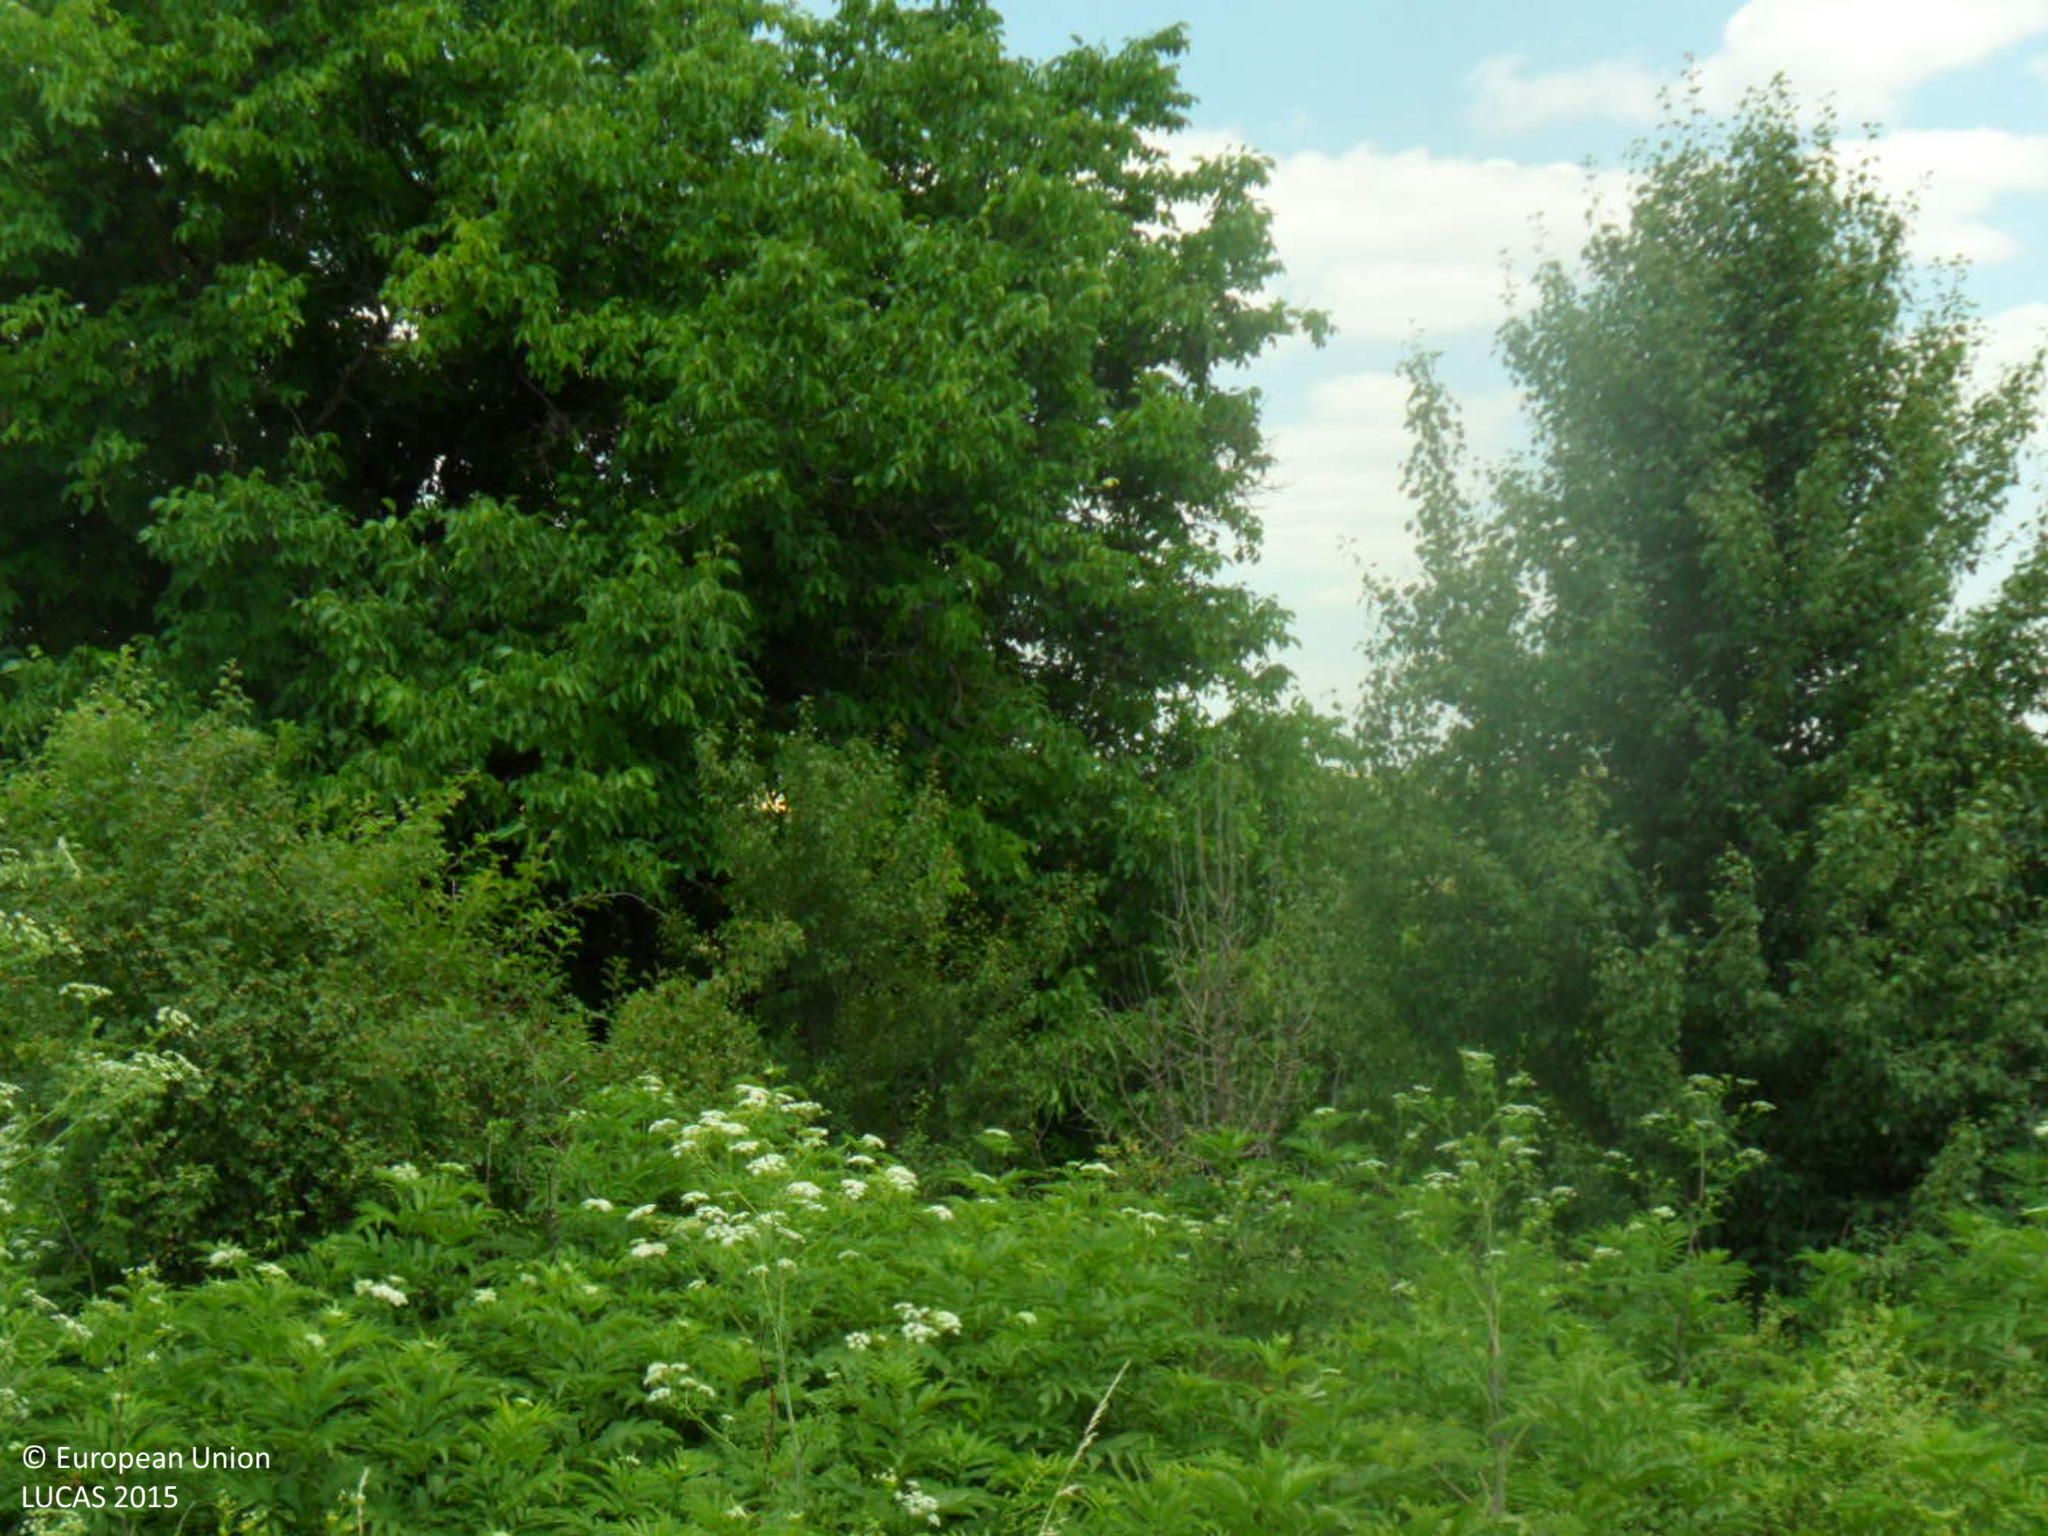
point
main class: Shrubland
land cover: Shrubland with sparse tree cover
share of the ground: > 75 %
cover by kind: shrubs 75 %, herbaceous plants 20 %, broadleaved forest trees 5 %
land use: Abandoned areas
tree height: > 5 m
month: June
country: BG
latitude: 43.4261
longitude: 26.9262
